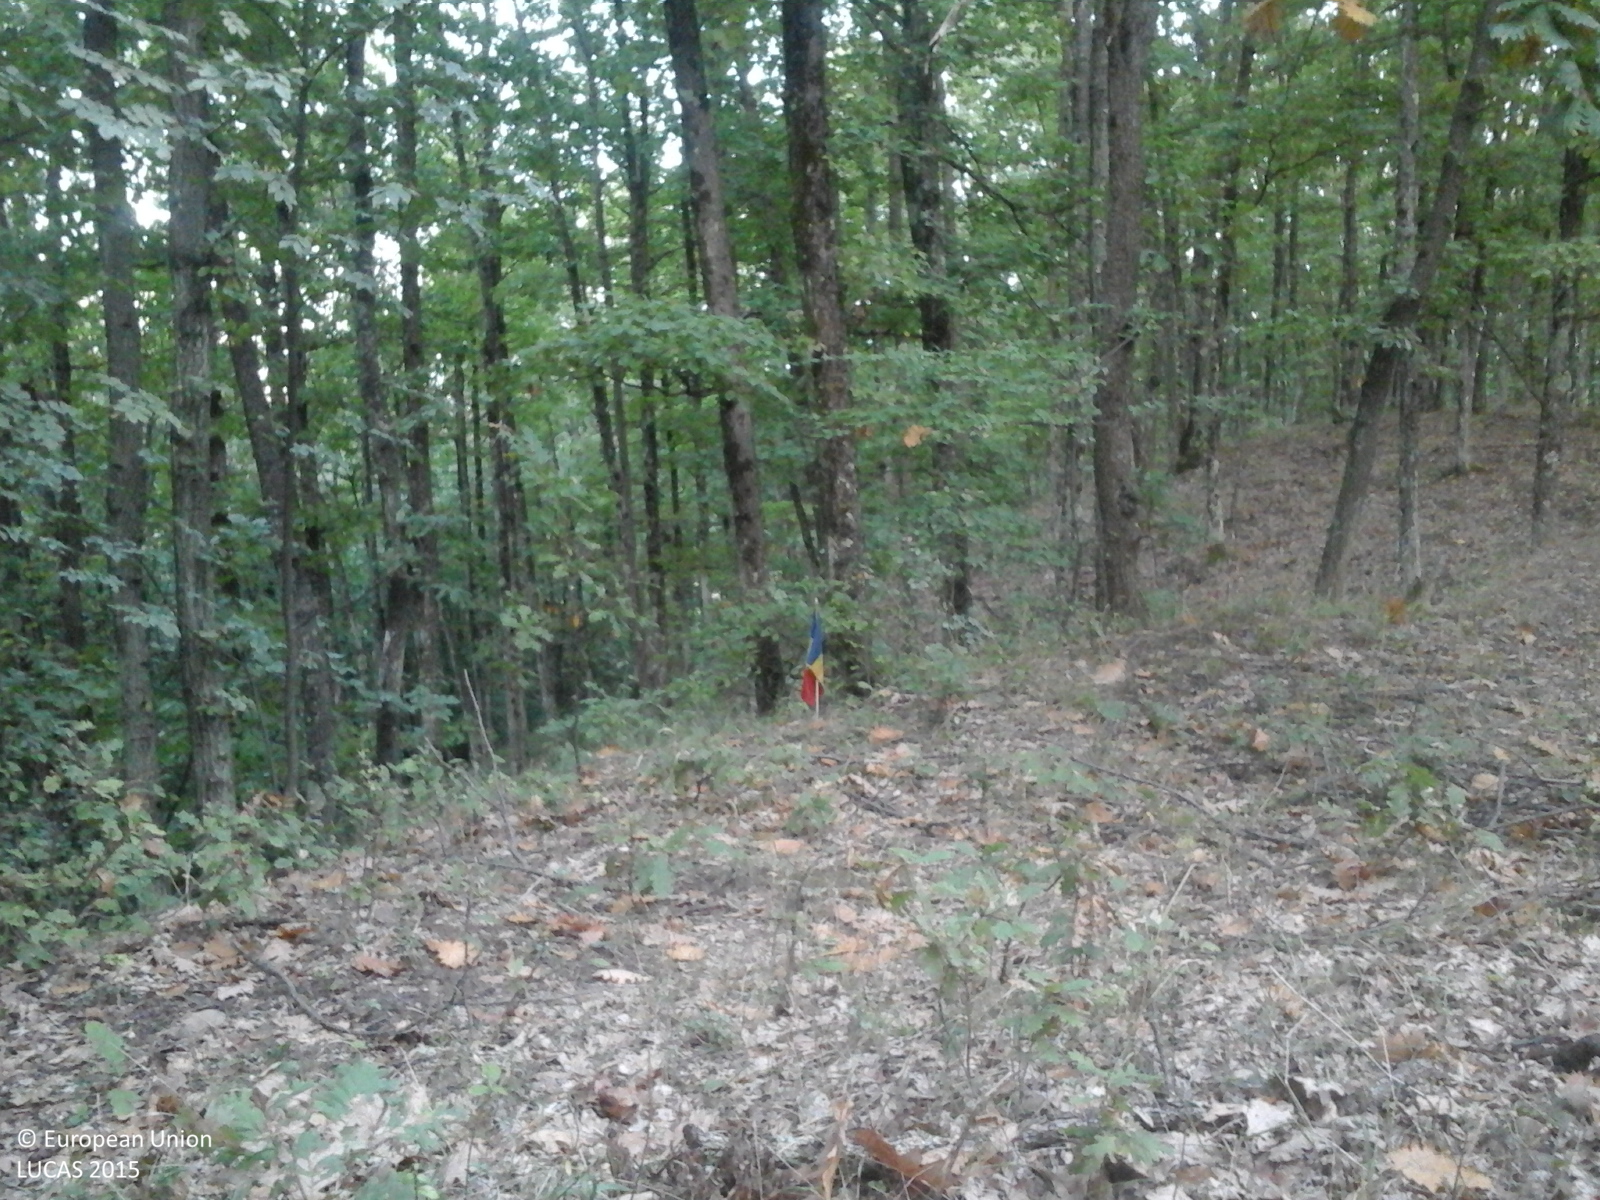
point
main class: Woodland
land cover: Broadleaved woodland
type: acidophilous oak and oak-birch forest
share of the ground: > 75 %
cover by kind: broadleaved forest trees 100 %
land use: Forestry
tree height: > 5 m
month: September
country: RO
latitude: 44.9025
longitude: 23.3904
